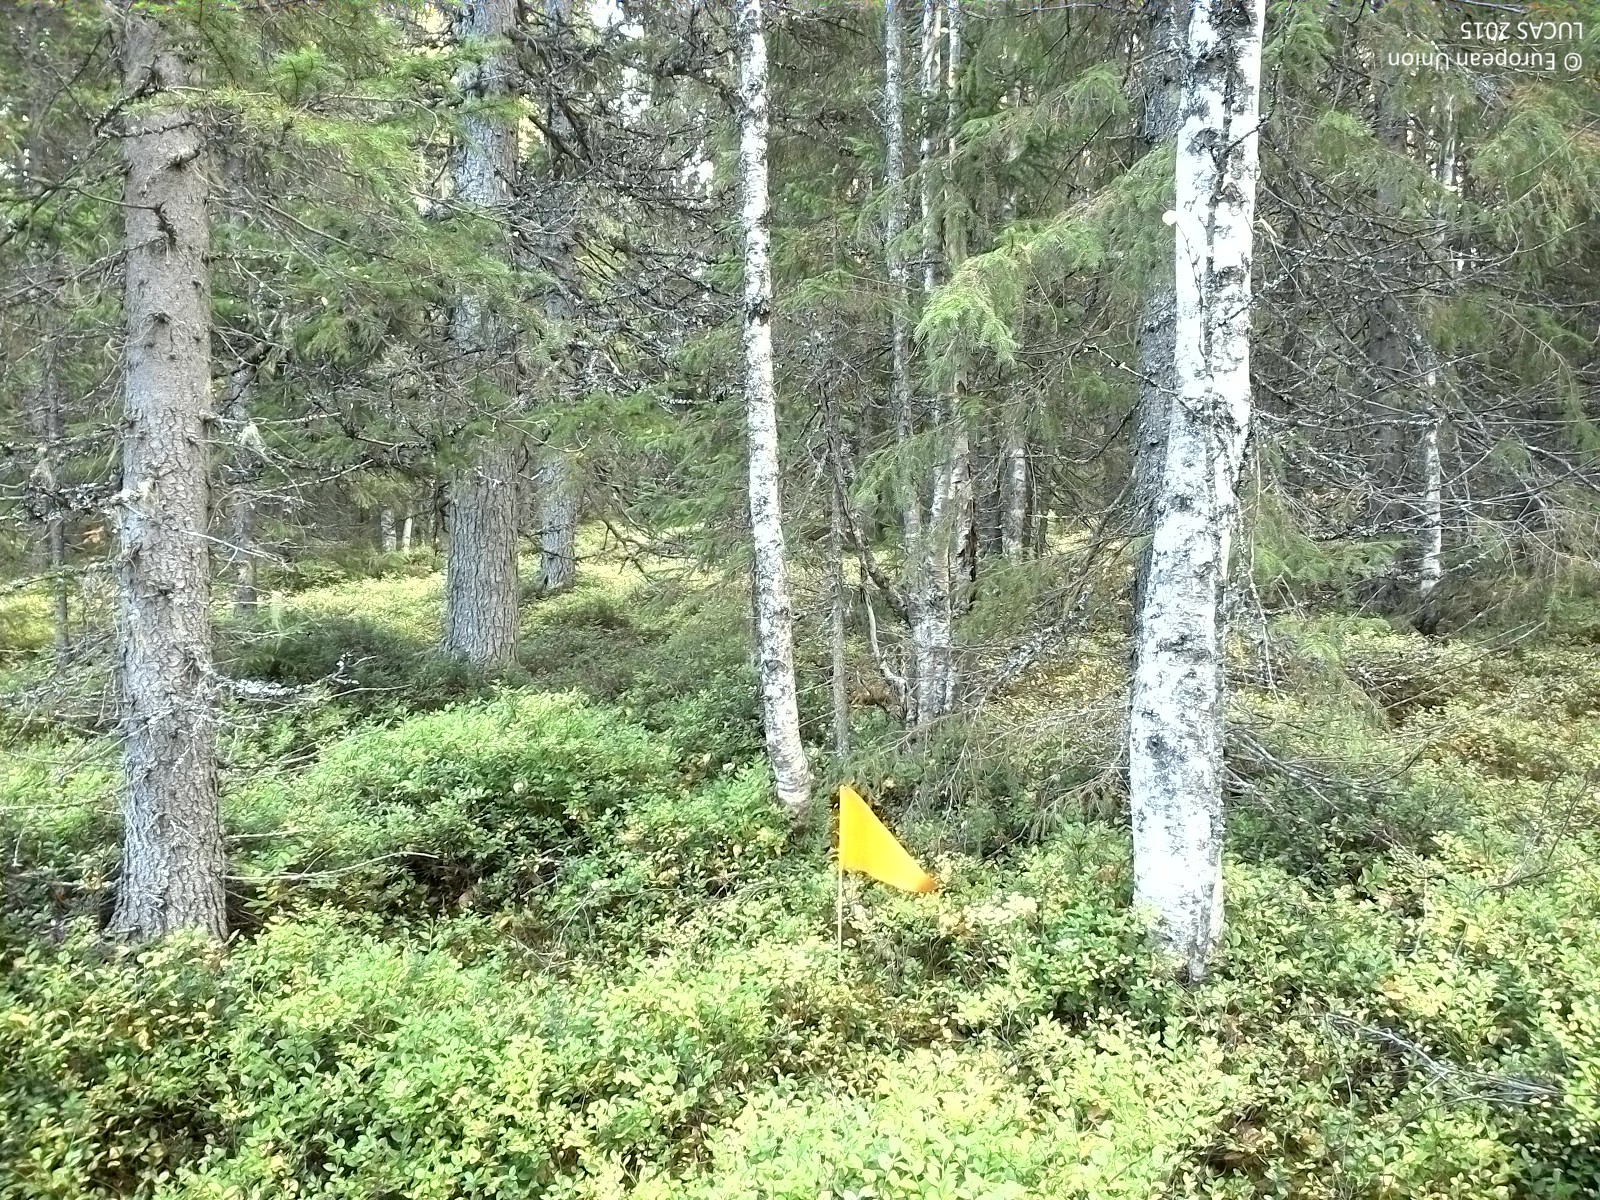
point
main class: Woodland
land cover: Spruce dominated mixed woodland
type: boreal forest
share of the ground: 25 - 50 %
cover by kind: shrubs 60 %, coniferous forest trees 30 %, broadleaved forest trees 10 %
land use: Forestry
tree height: > 5 m
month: September
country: SE
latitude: 62.2611
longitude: 16.3550
